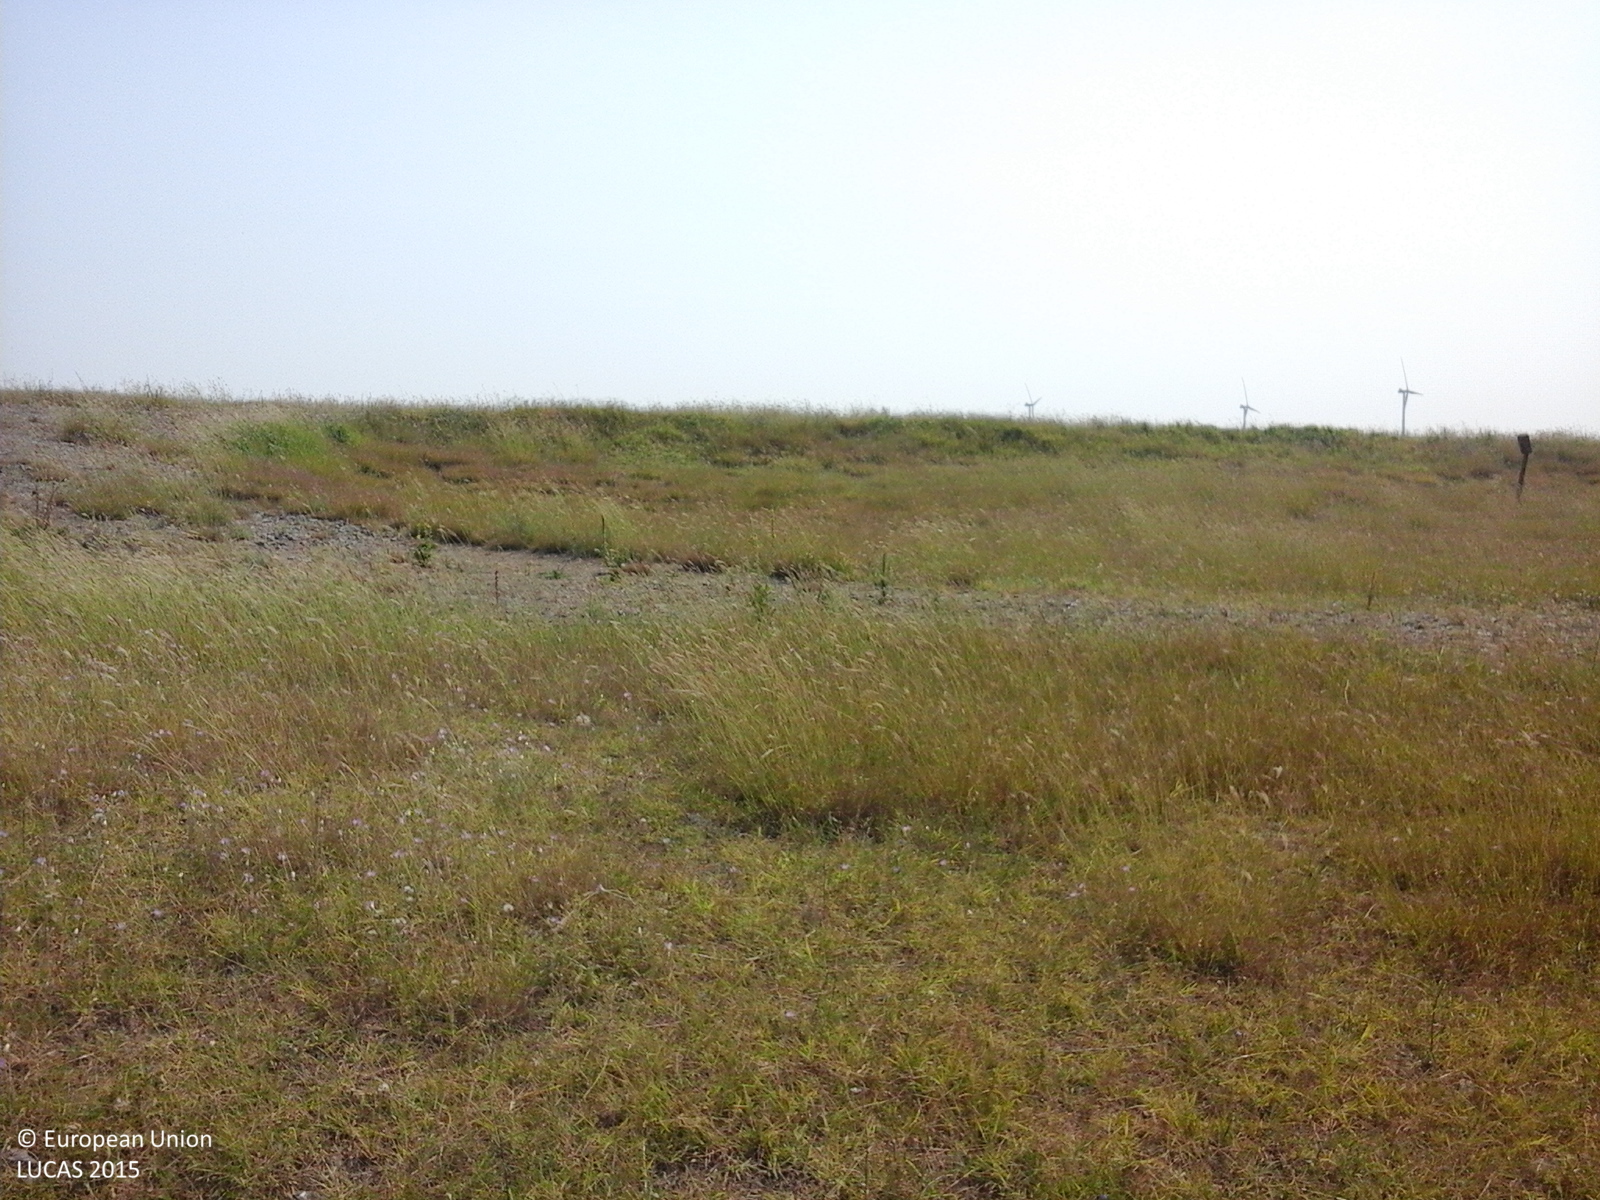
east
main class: Grassland
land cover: Grassland without tree/shrub cover
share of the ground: > 75 %
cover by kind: herbaceous plants 100 %
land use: Agriculture (excluding fallow land and kitchen gardens)
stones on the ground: 10 - 25 %
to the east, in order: Grassland without tree/shrub cover; Tracks; Grassland without tree/shrub cover; Tracks; Grass margins; Common wheat
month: July
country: RO
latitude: 45.5388
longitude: 27.8238
